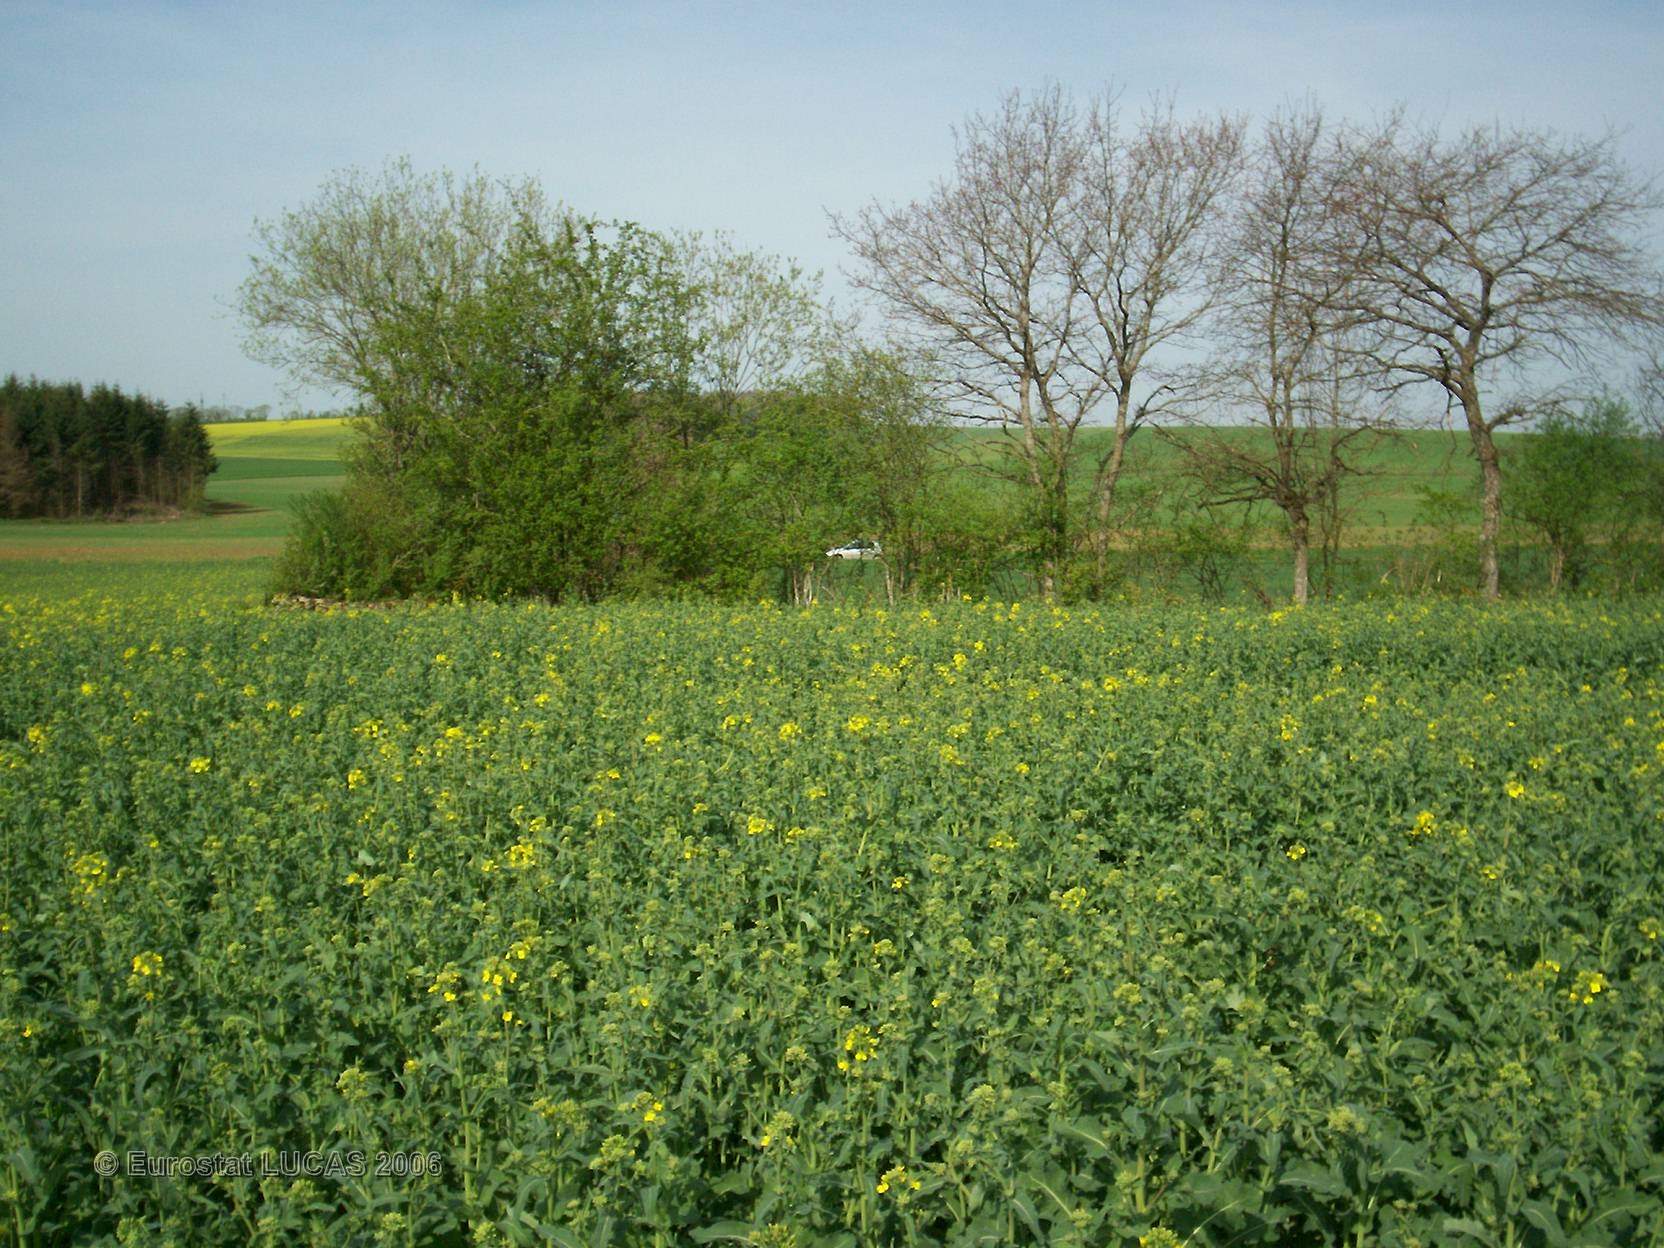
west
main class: Cropland
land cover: Rape and turnip rape
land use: Agriculture (excluding fallow land and kitchen gardens)
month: May
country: FR
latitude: 47.6035
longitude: 4.5854
